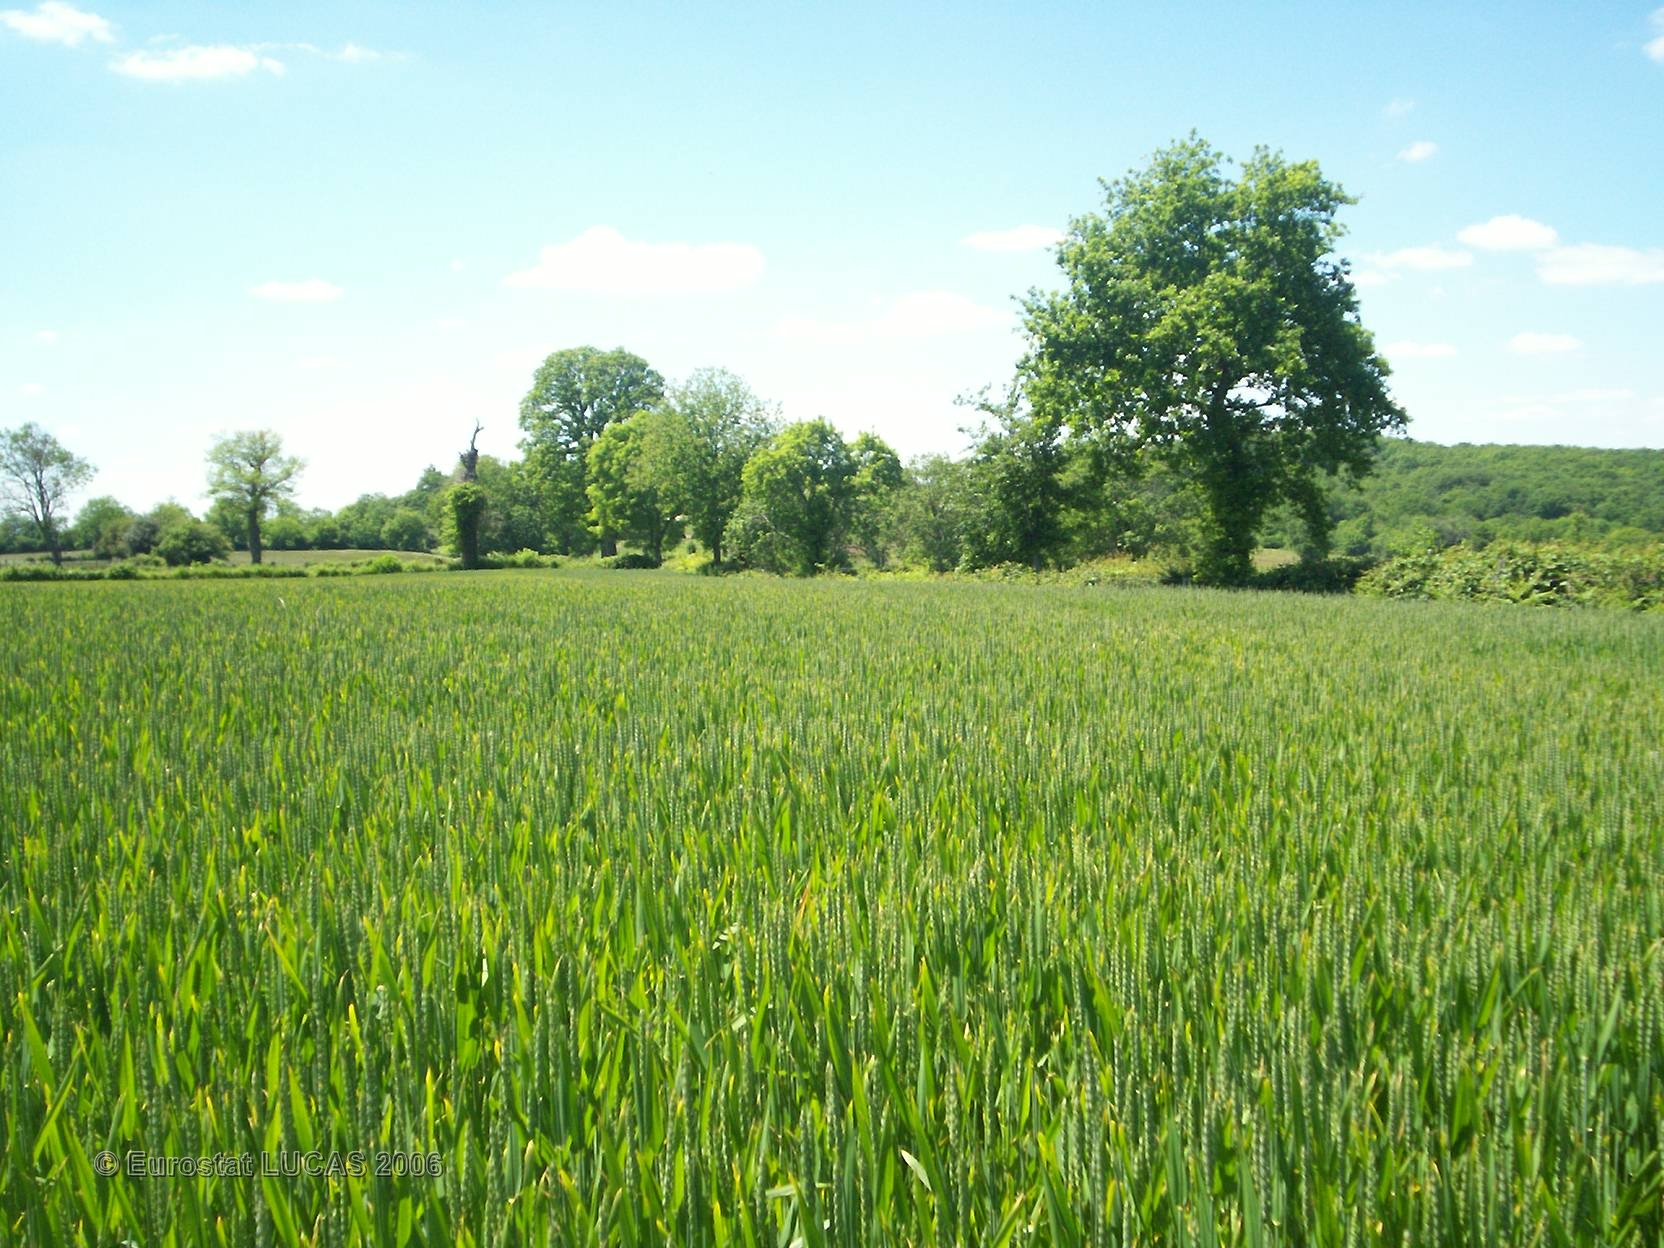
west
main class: Cropland
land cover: Common wheat
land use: Agriculture (excluding fallow land and kitchen gardens)
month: June
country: FR
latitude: 46.2581
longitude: 2.8753
